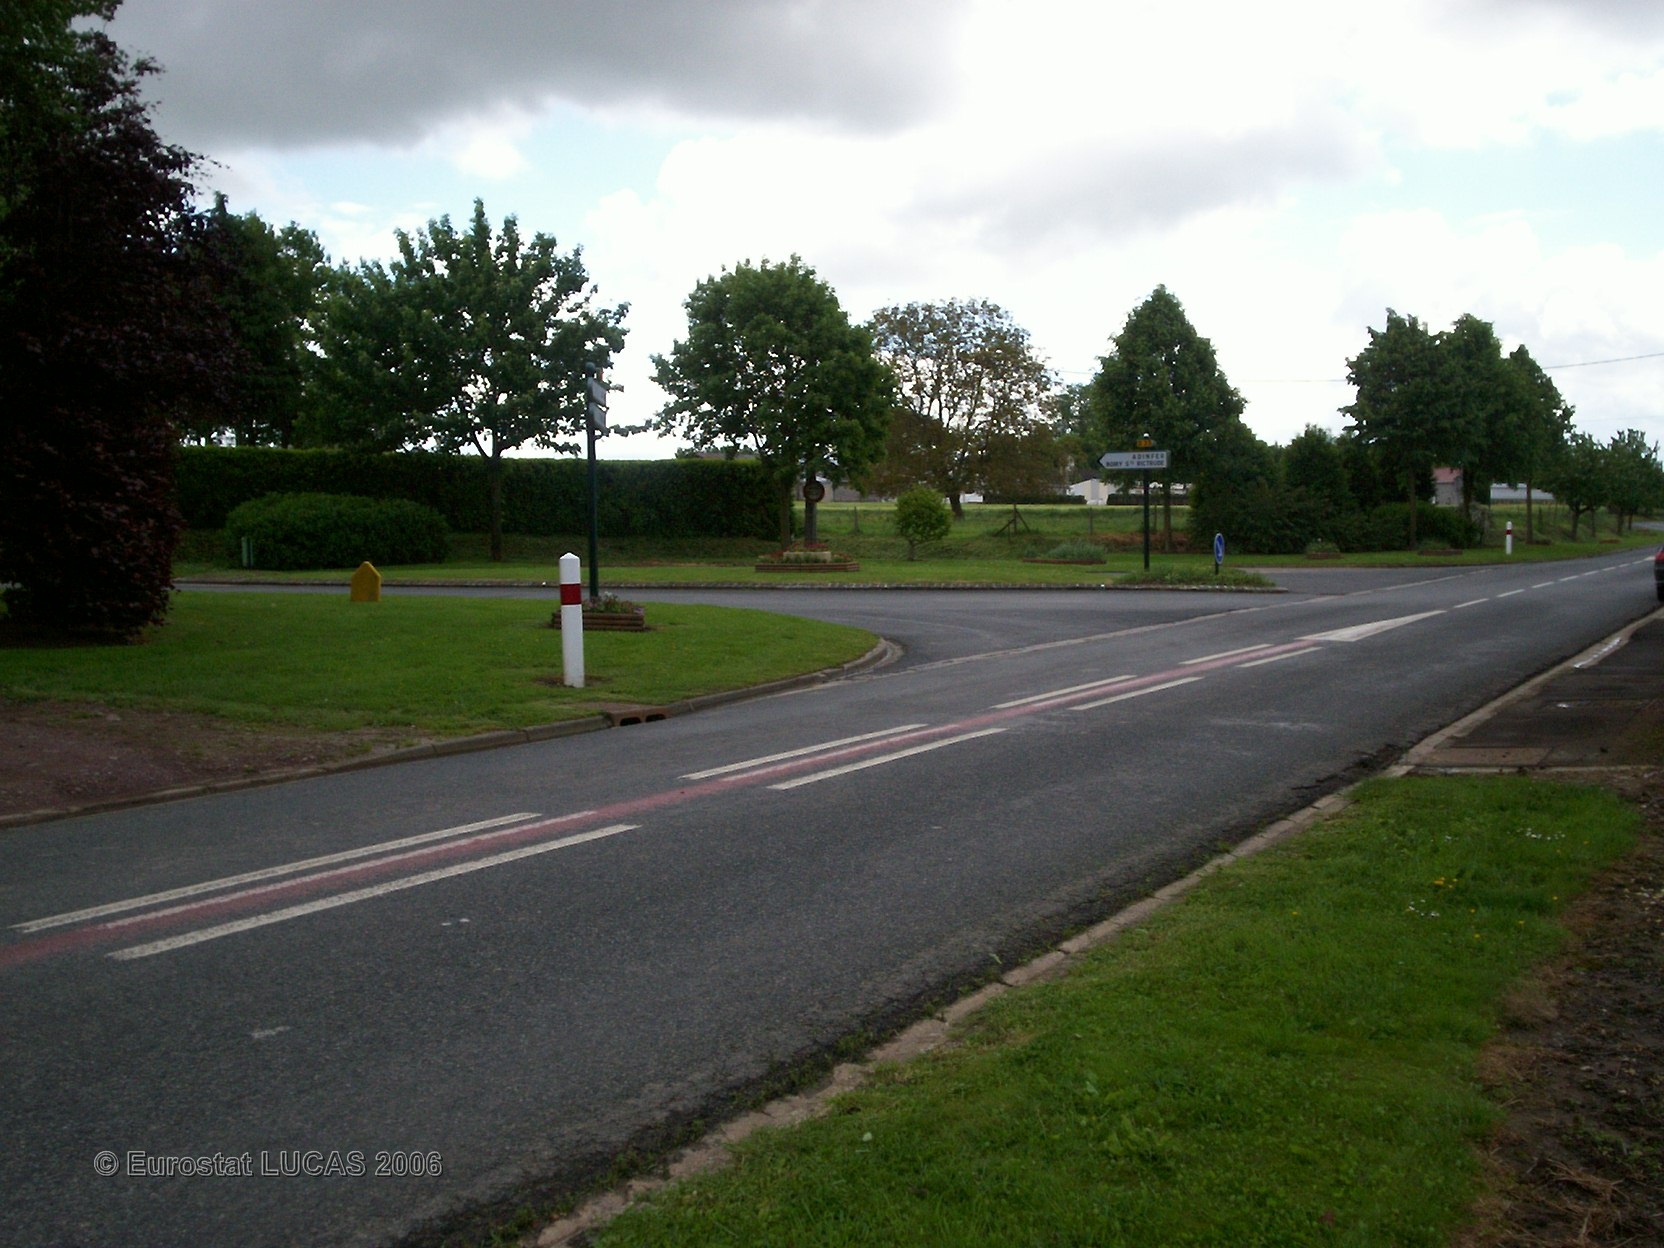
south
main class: Grassland
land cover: Grassland with sparse tree/shrub cover
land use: Agriculture (excluding fallow land and kitchen gardens)
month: May
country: FR
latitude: 50.1825
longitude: 2.6641
